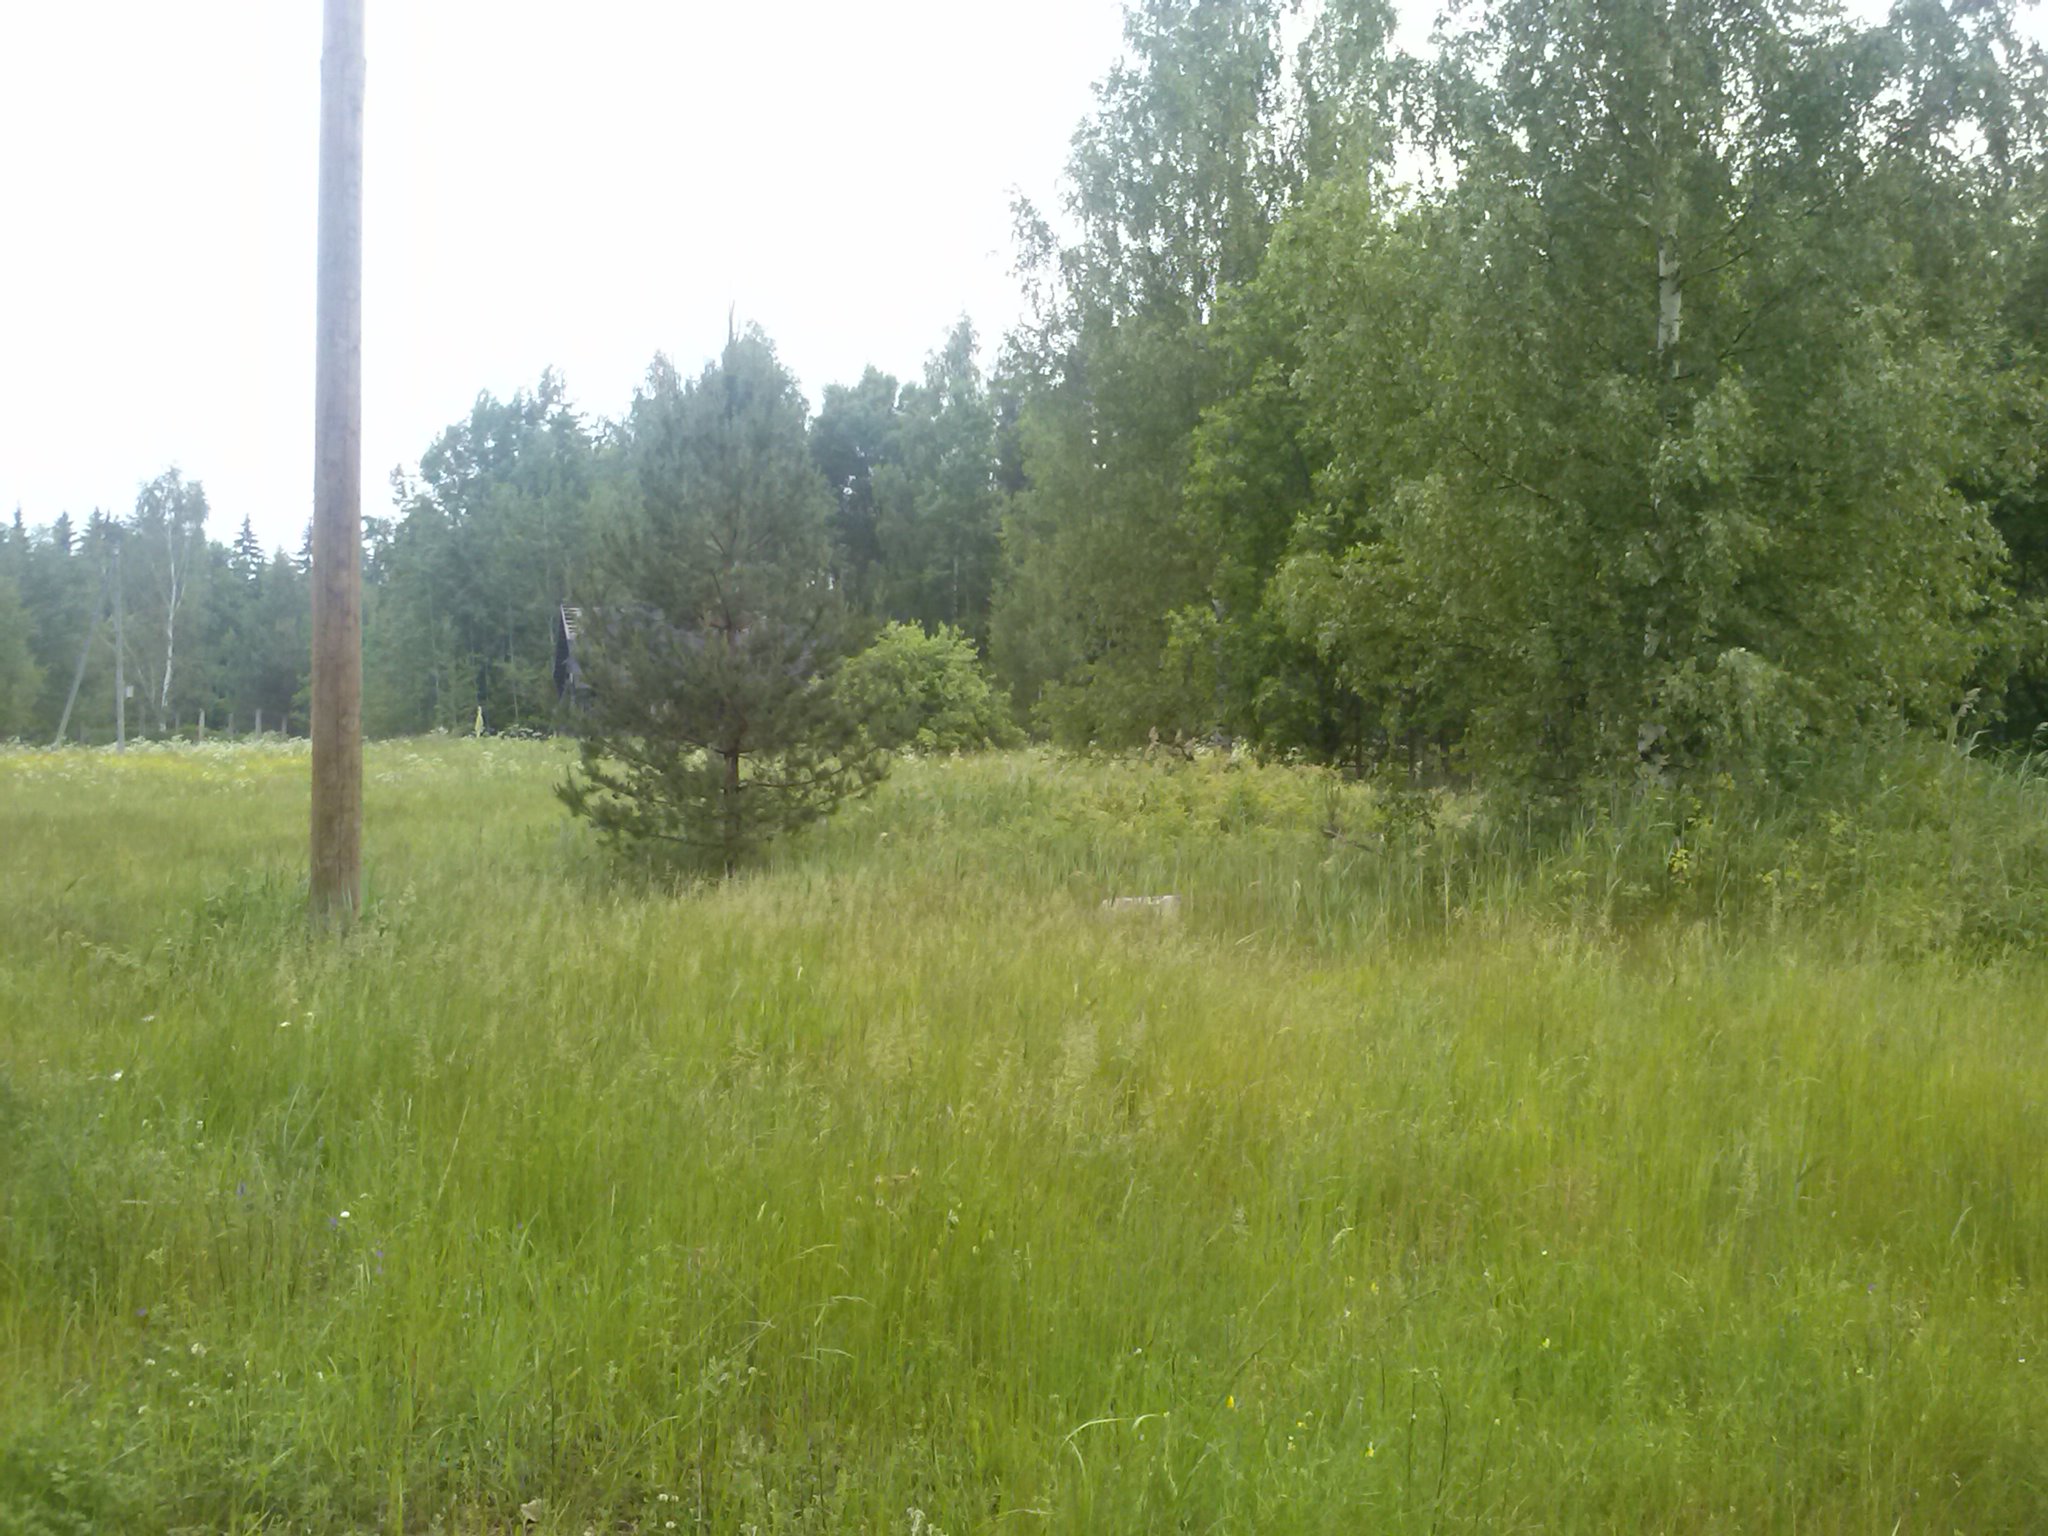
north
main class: Woodland
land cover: Broadleaved woodland
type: non-riverine alder, birch or aspen forest
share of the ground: 50 - 75 %
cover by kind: broadleaved forest trees 50 %, herbaceous plants 40 %, coniferous forest trees 5 %, shrubs 5 %
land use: Abandoned areas
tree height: > 5 m
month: June
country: LV
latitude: 56.9127
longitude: 27.1993
